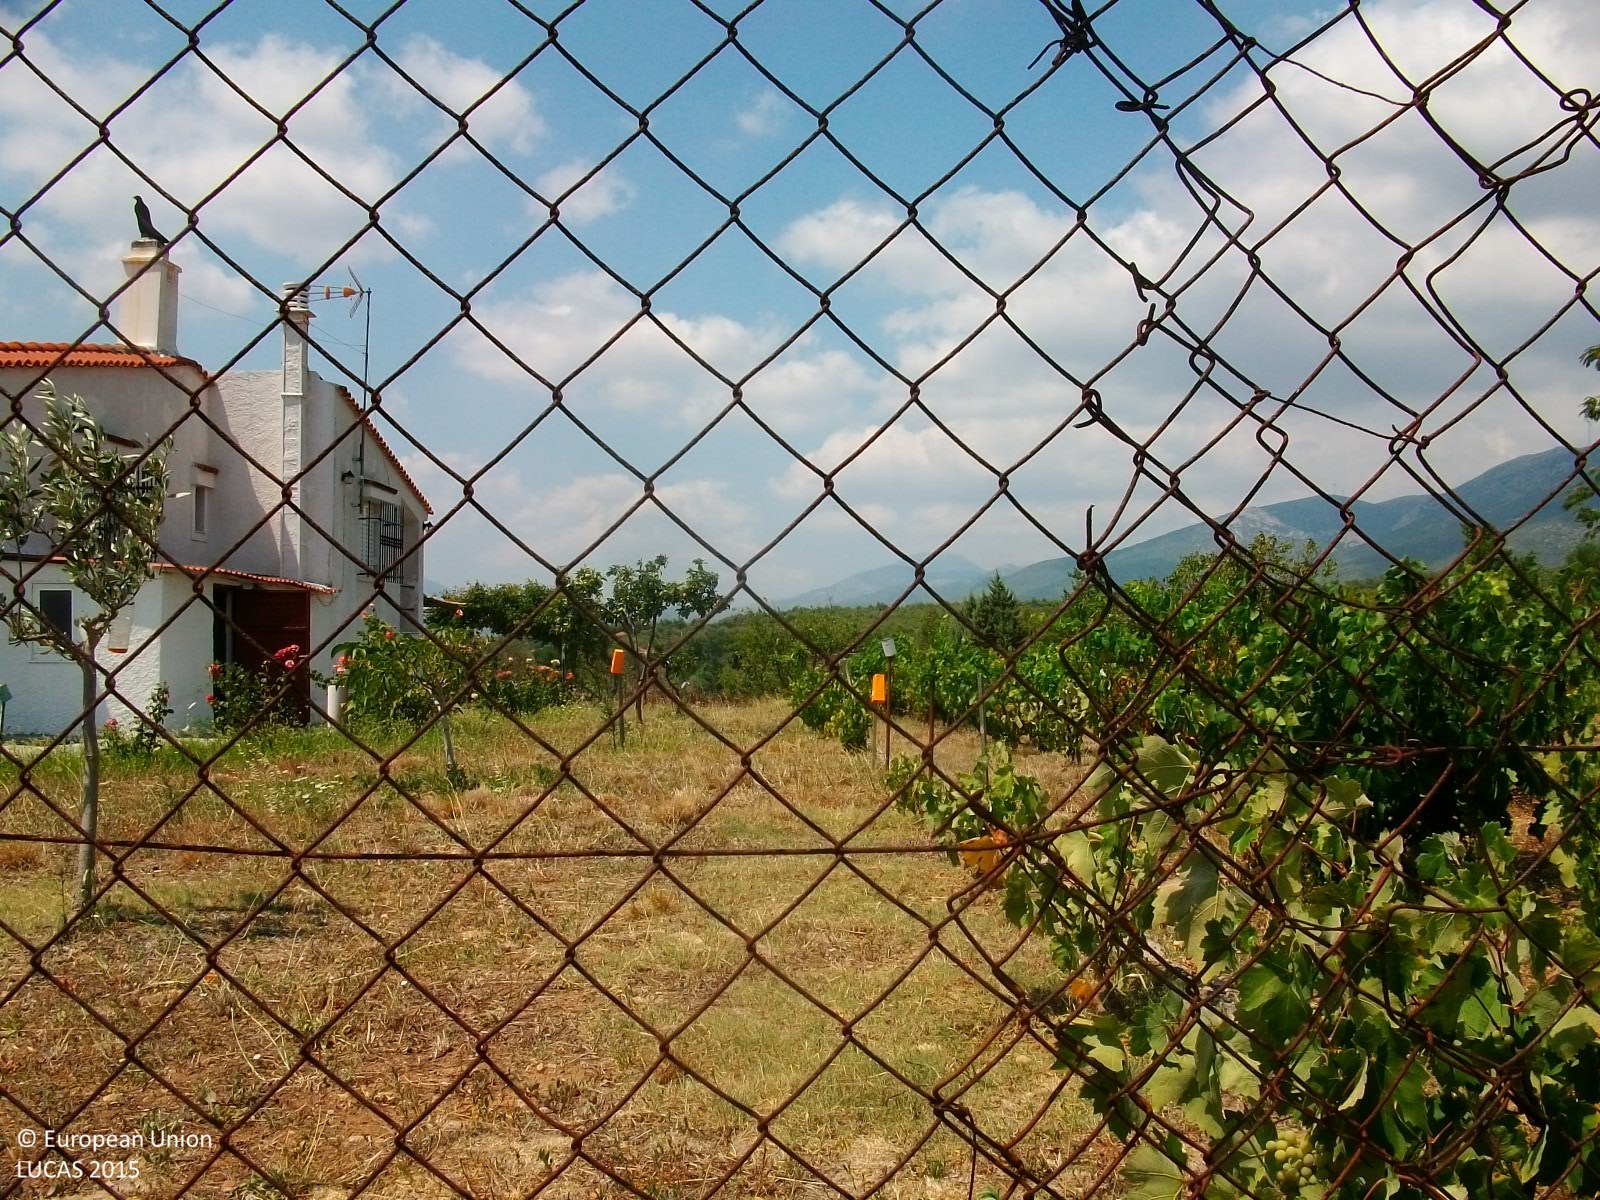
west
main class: Cropland
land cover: Vineyards
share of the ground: 25 - 50 %
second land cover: Grassland without tree/shrub cover
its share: > 75 %
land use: Kitchen garden
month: August
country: GR
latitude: 38.1801
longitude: 23.4628
